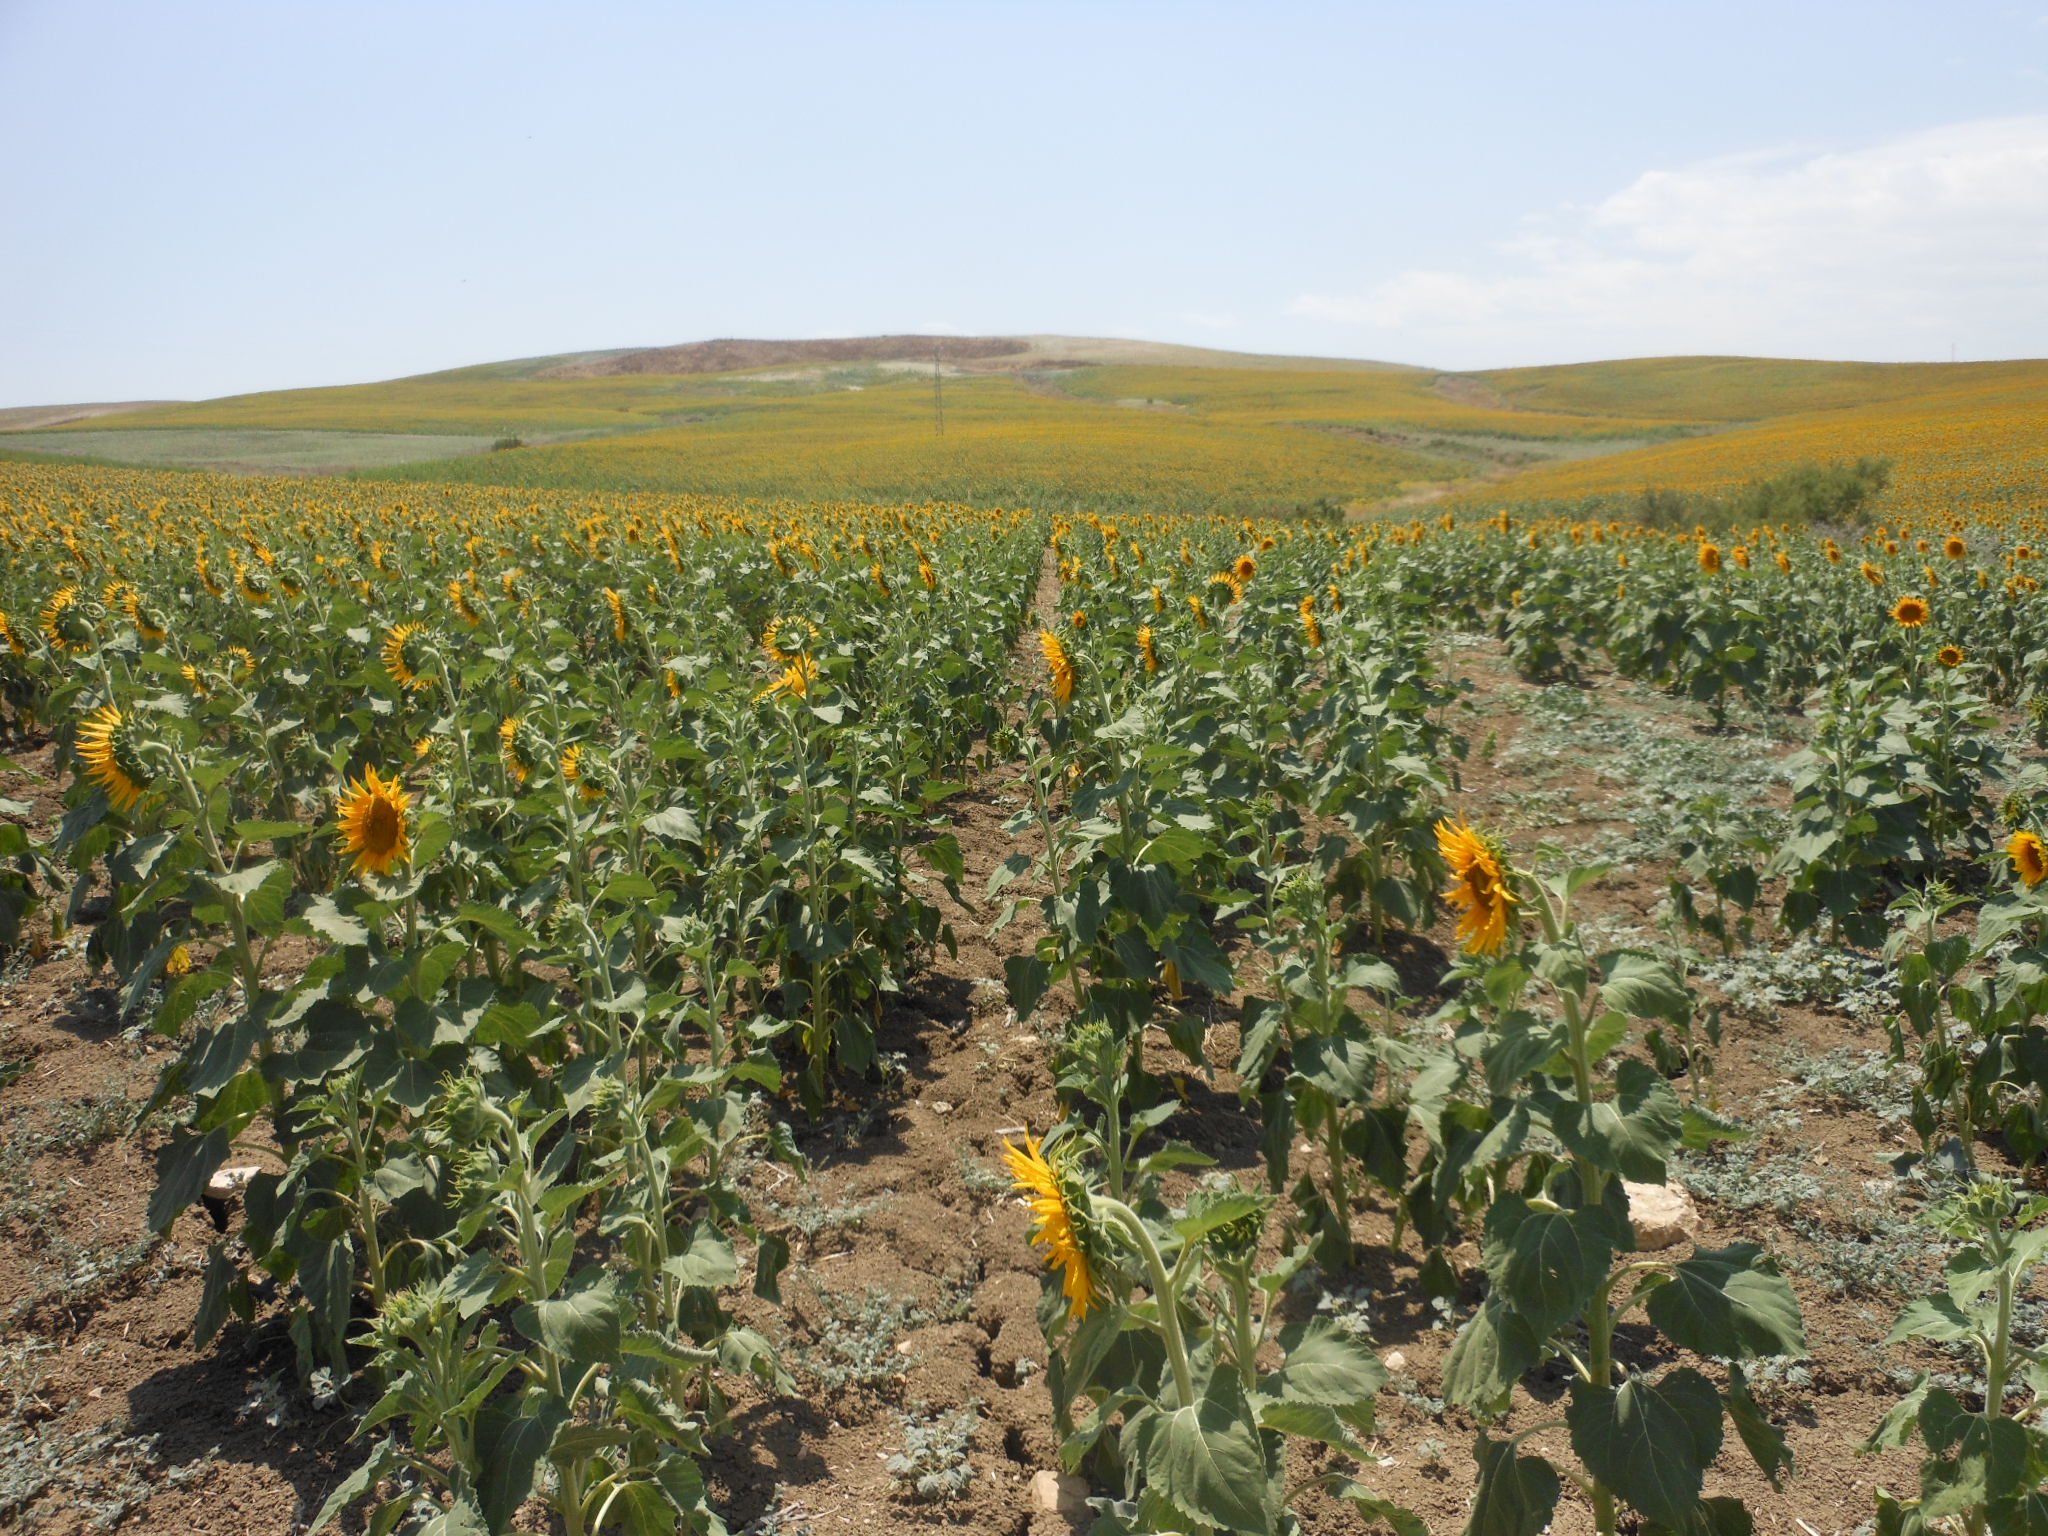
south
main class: Cropland
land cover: Sunflower
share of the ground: > 75 %
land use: Agriculture (excluding fallow land and kitchen gardens)
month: June
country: ES
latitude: 37.4541
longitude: -5.1031
